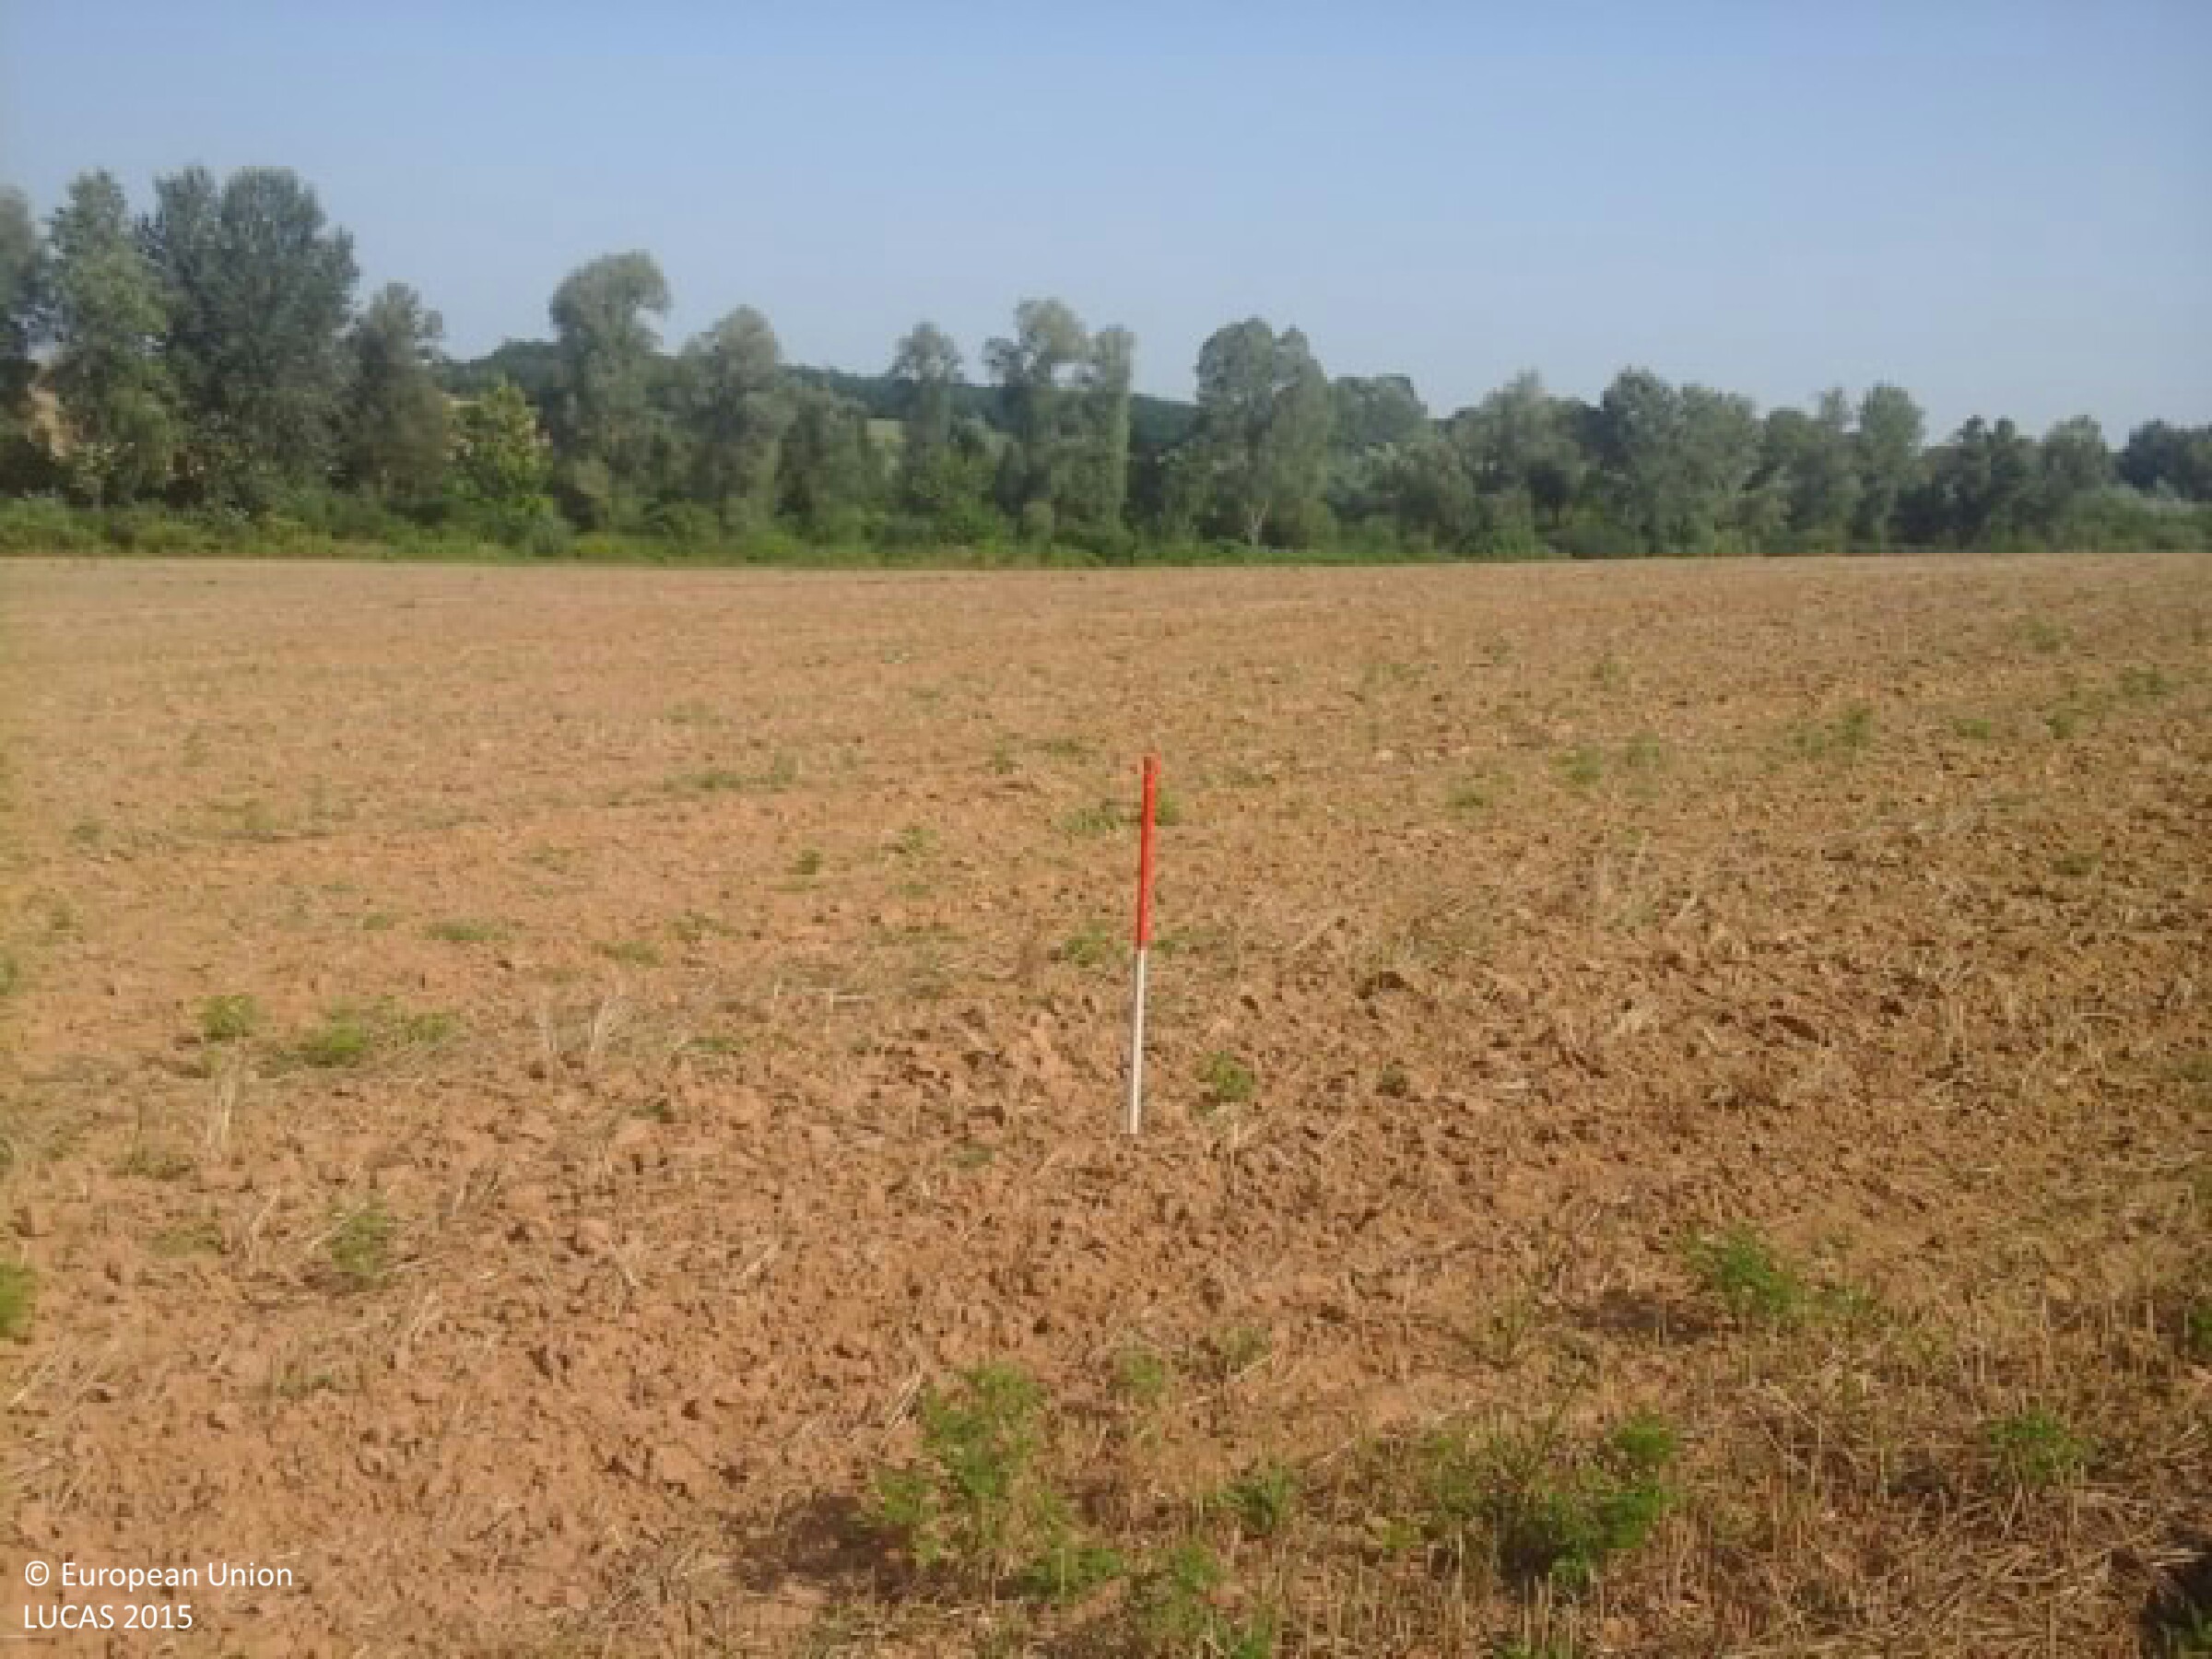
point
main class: Cropland
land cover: Triticale
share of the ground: < 10 %
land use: Agriculture (excluding fallow land and kitchen gardens)
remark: Harvested field
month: August
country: HU
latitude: 46.3611
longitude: 18.2093
